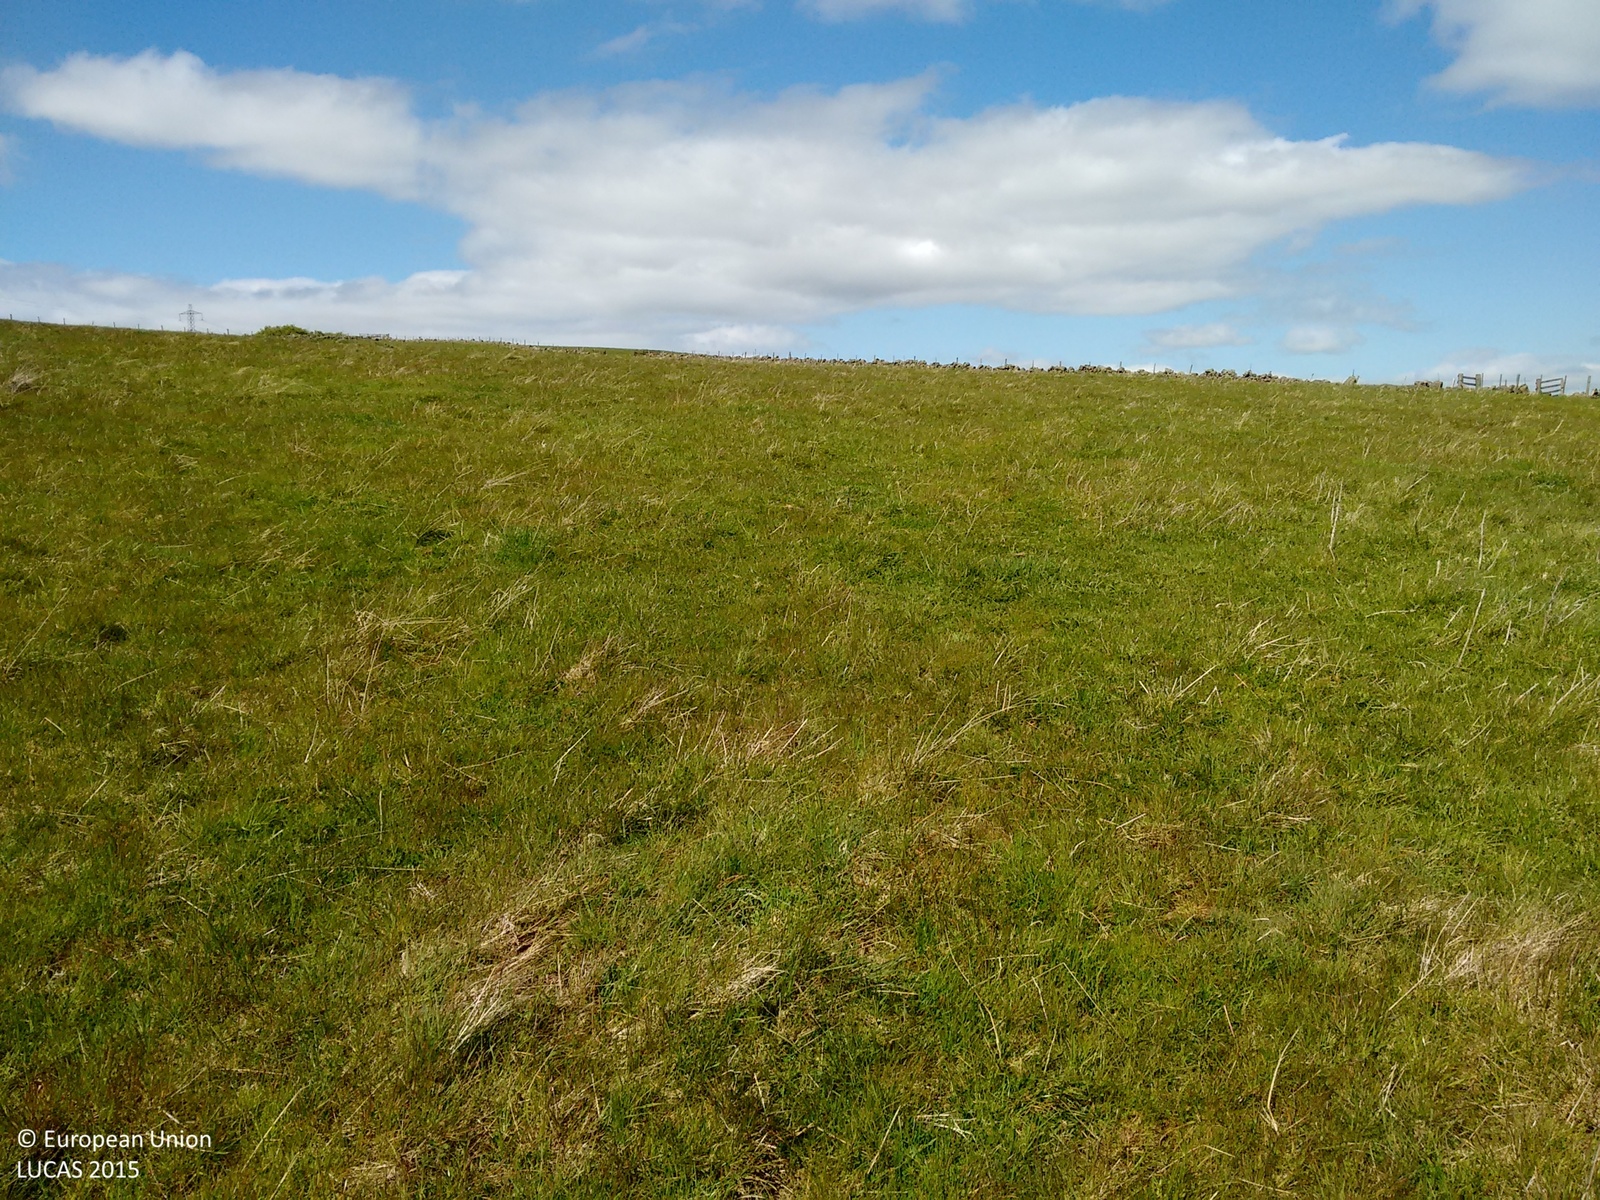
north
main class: Grassland
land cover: Grassland without tree/shrub cover
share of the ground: > 75 %
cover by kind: herbaceous plants 100 %
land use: Agriculture (excluding fallow land and kitchen gardens)
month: May
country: GB
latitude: 56.2629
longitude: -3.4263
